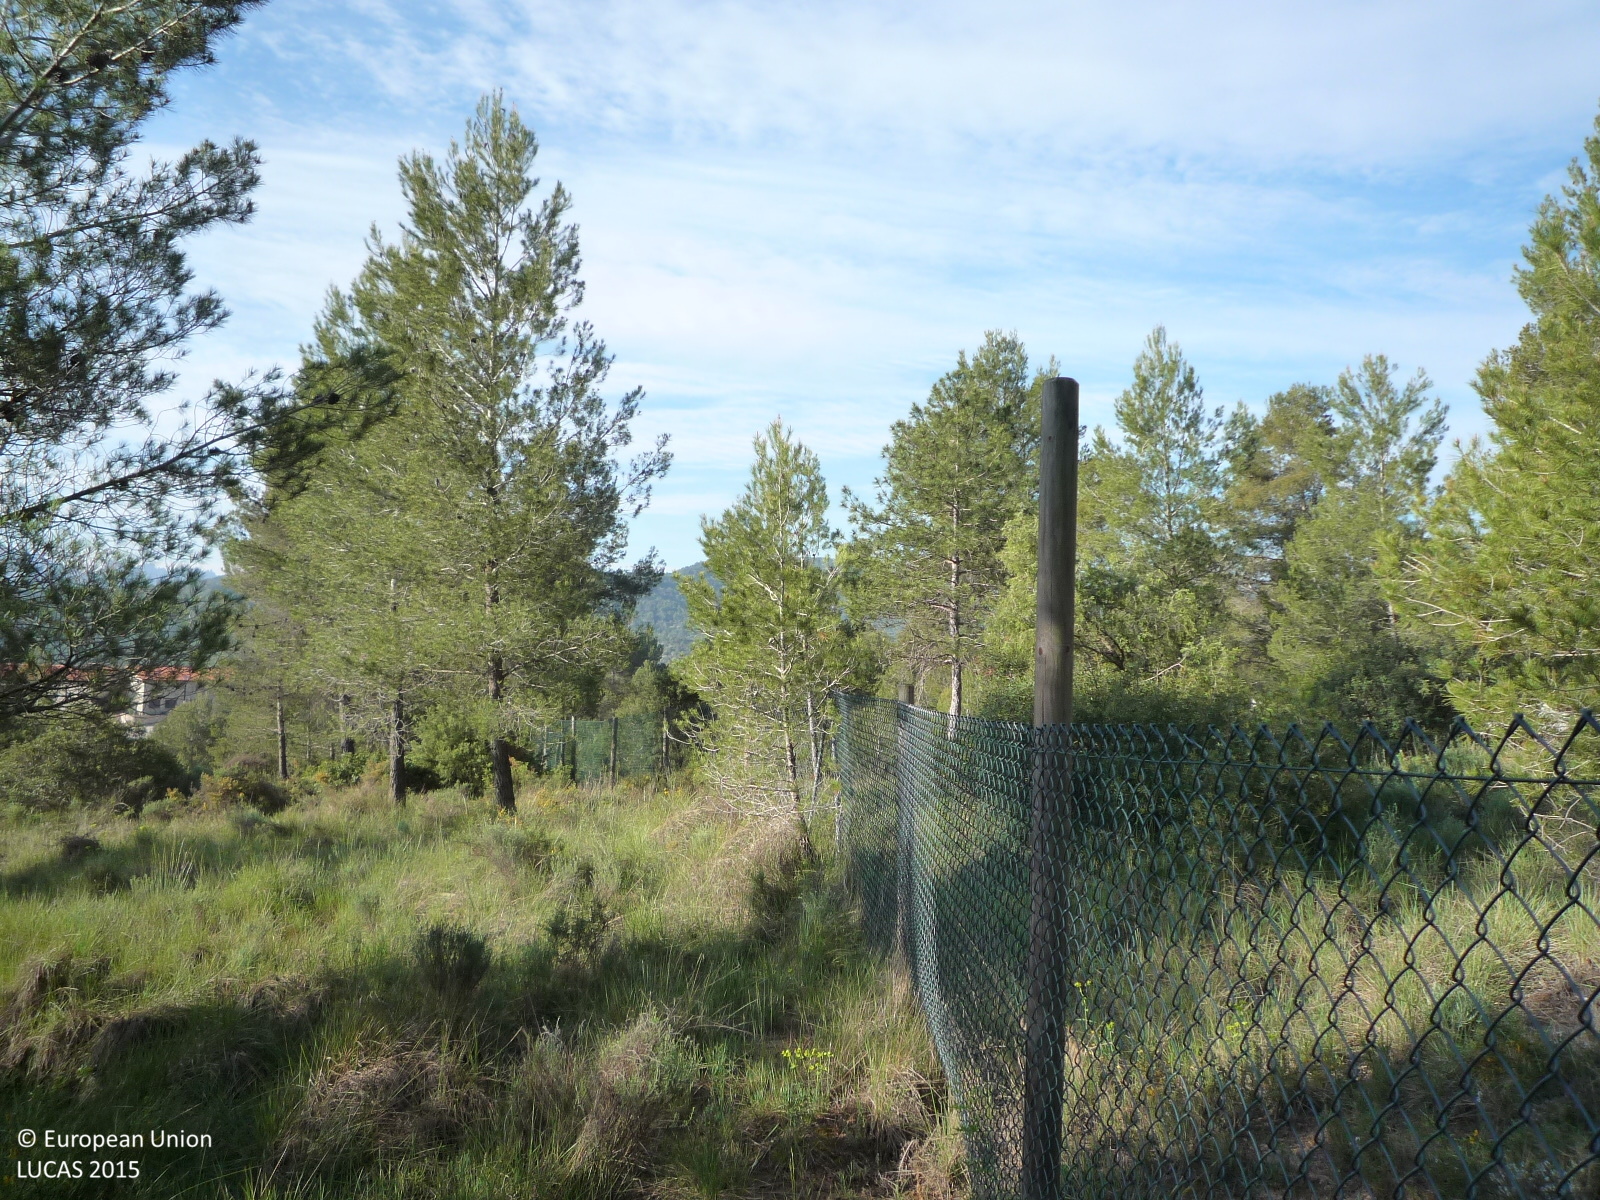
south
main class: Woodland
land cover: Pine dominated coniferous woodland
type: coniferous forest of the mediterranean region
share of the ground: > 75 %
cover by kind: coniferous forest trees 75 %, shrubs 25 %
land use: Residential
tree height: > 5 m
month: April
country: ES
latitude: 41.7187
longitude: 1.7573
